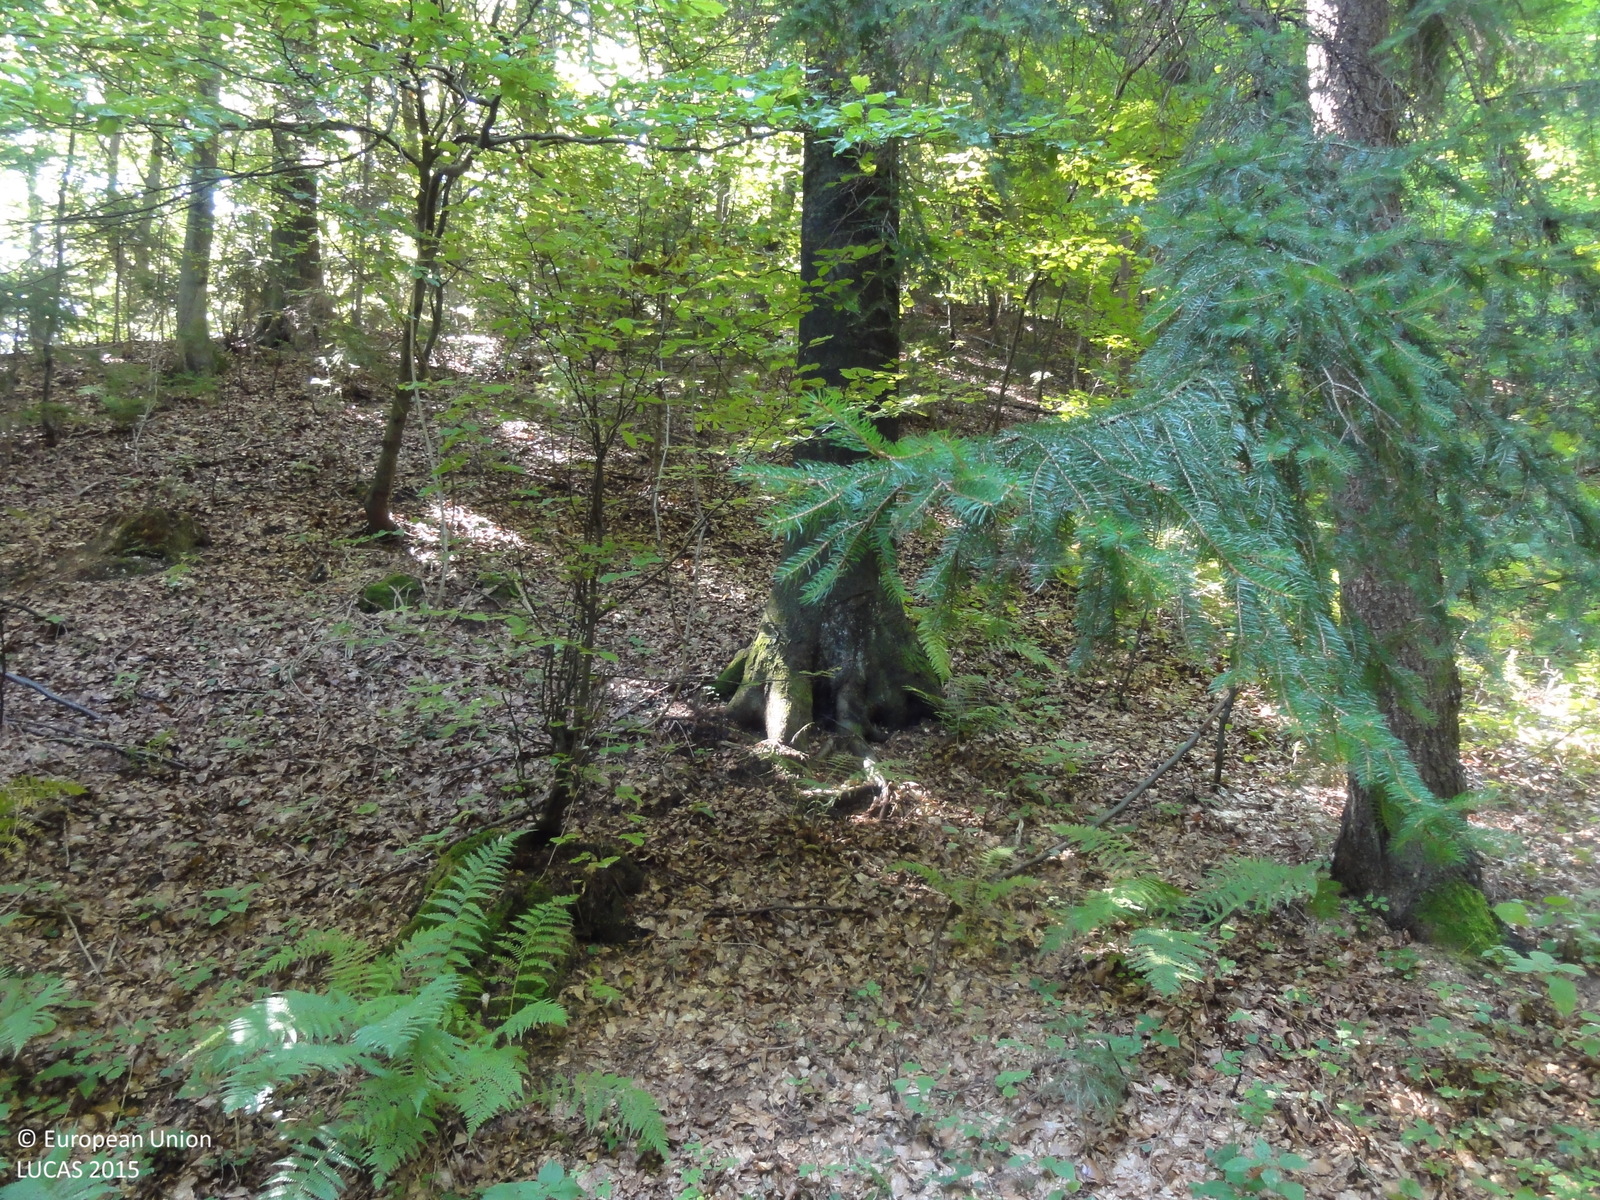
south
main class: Woodland
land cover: Spruce dominated mixed woodland
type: mountainous beech forest
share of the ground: > 75 %
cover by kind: broadleaved forest trees 60 %, coniferous forest trees 25 %, herbaceous plants 10 %, shrubs 5 %
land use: Forestry
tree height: > 5 m
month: August
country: SI
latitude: 46.1556
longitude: 15.1380
